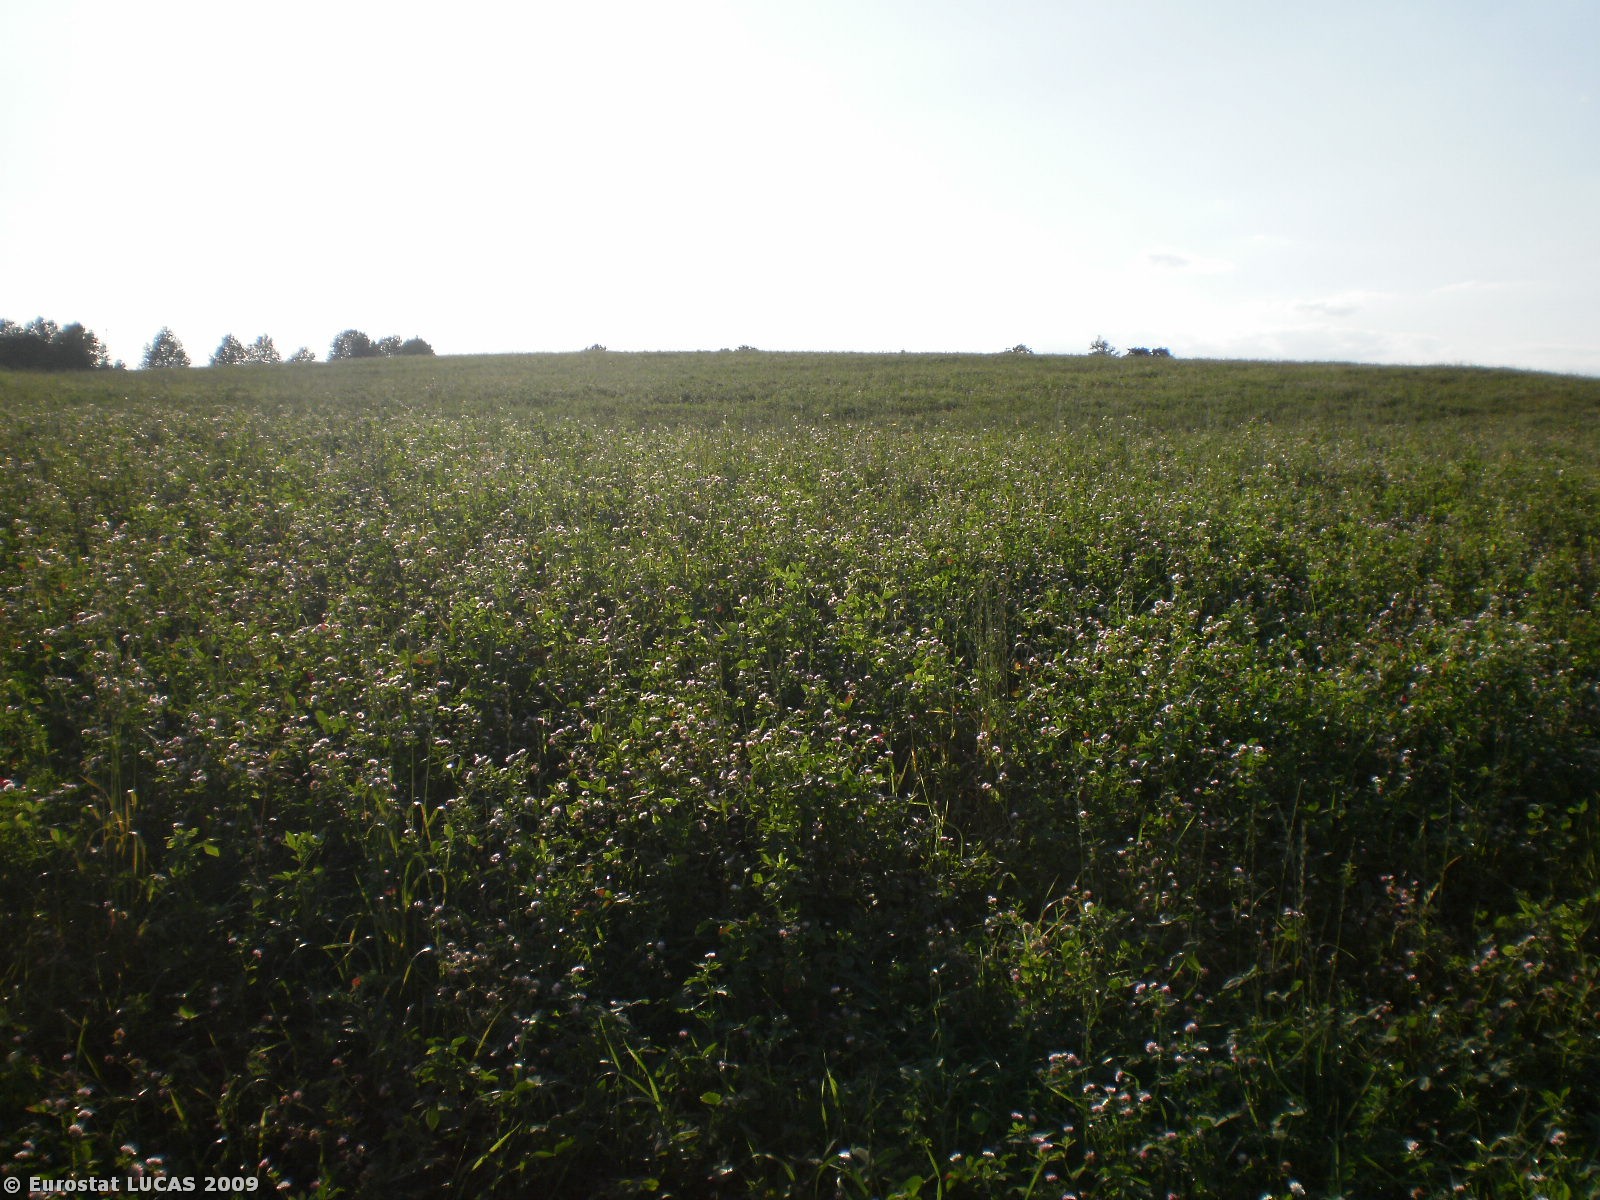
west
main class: Grassland
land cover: Grassland without tree/shrub cover
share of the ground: > 75 %
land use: Unused
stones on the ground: < 10 %
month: August
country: PL
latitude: 53.8492
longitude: 21.7116
